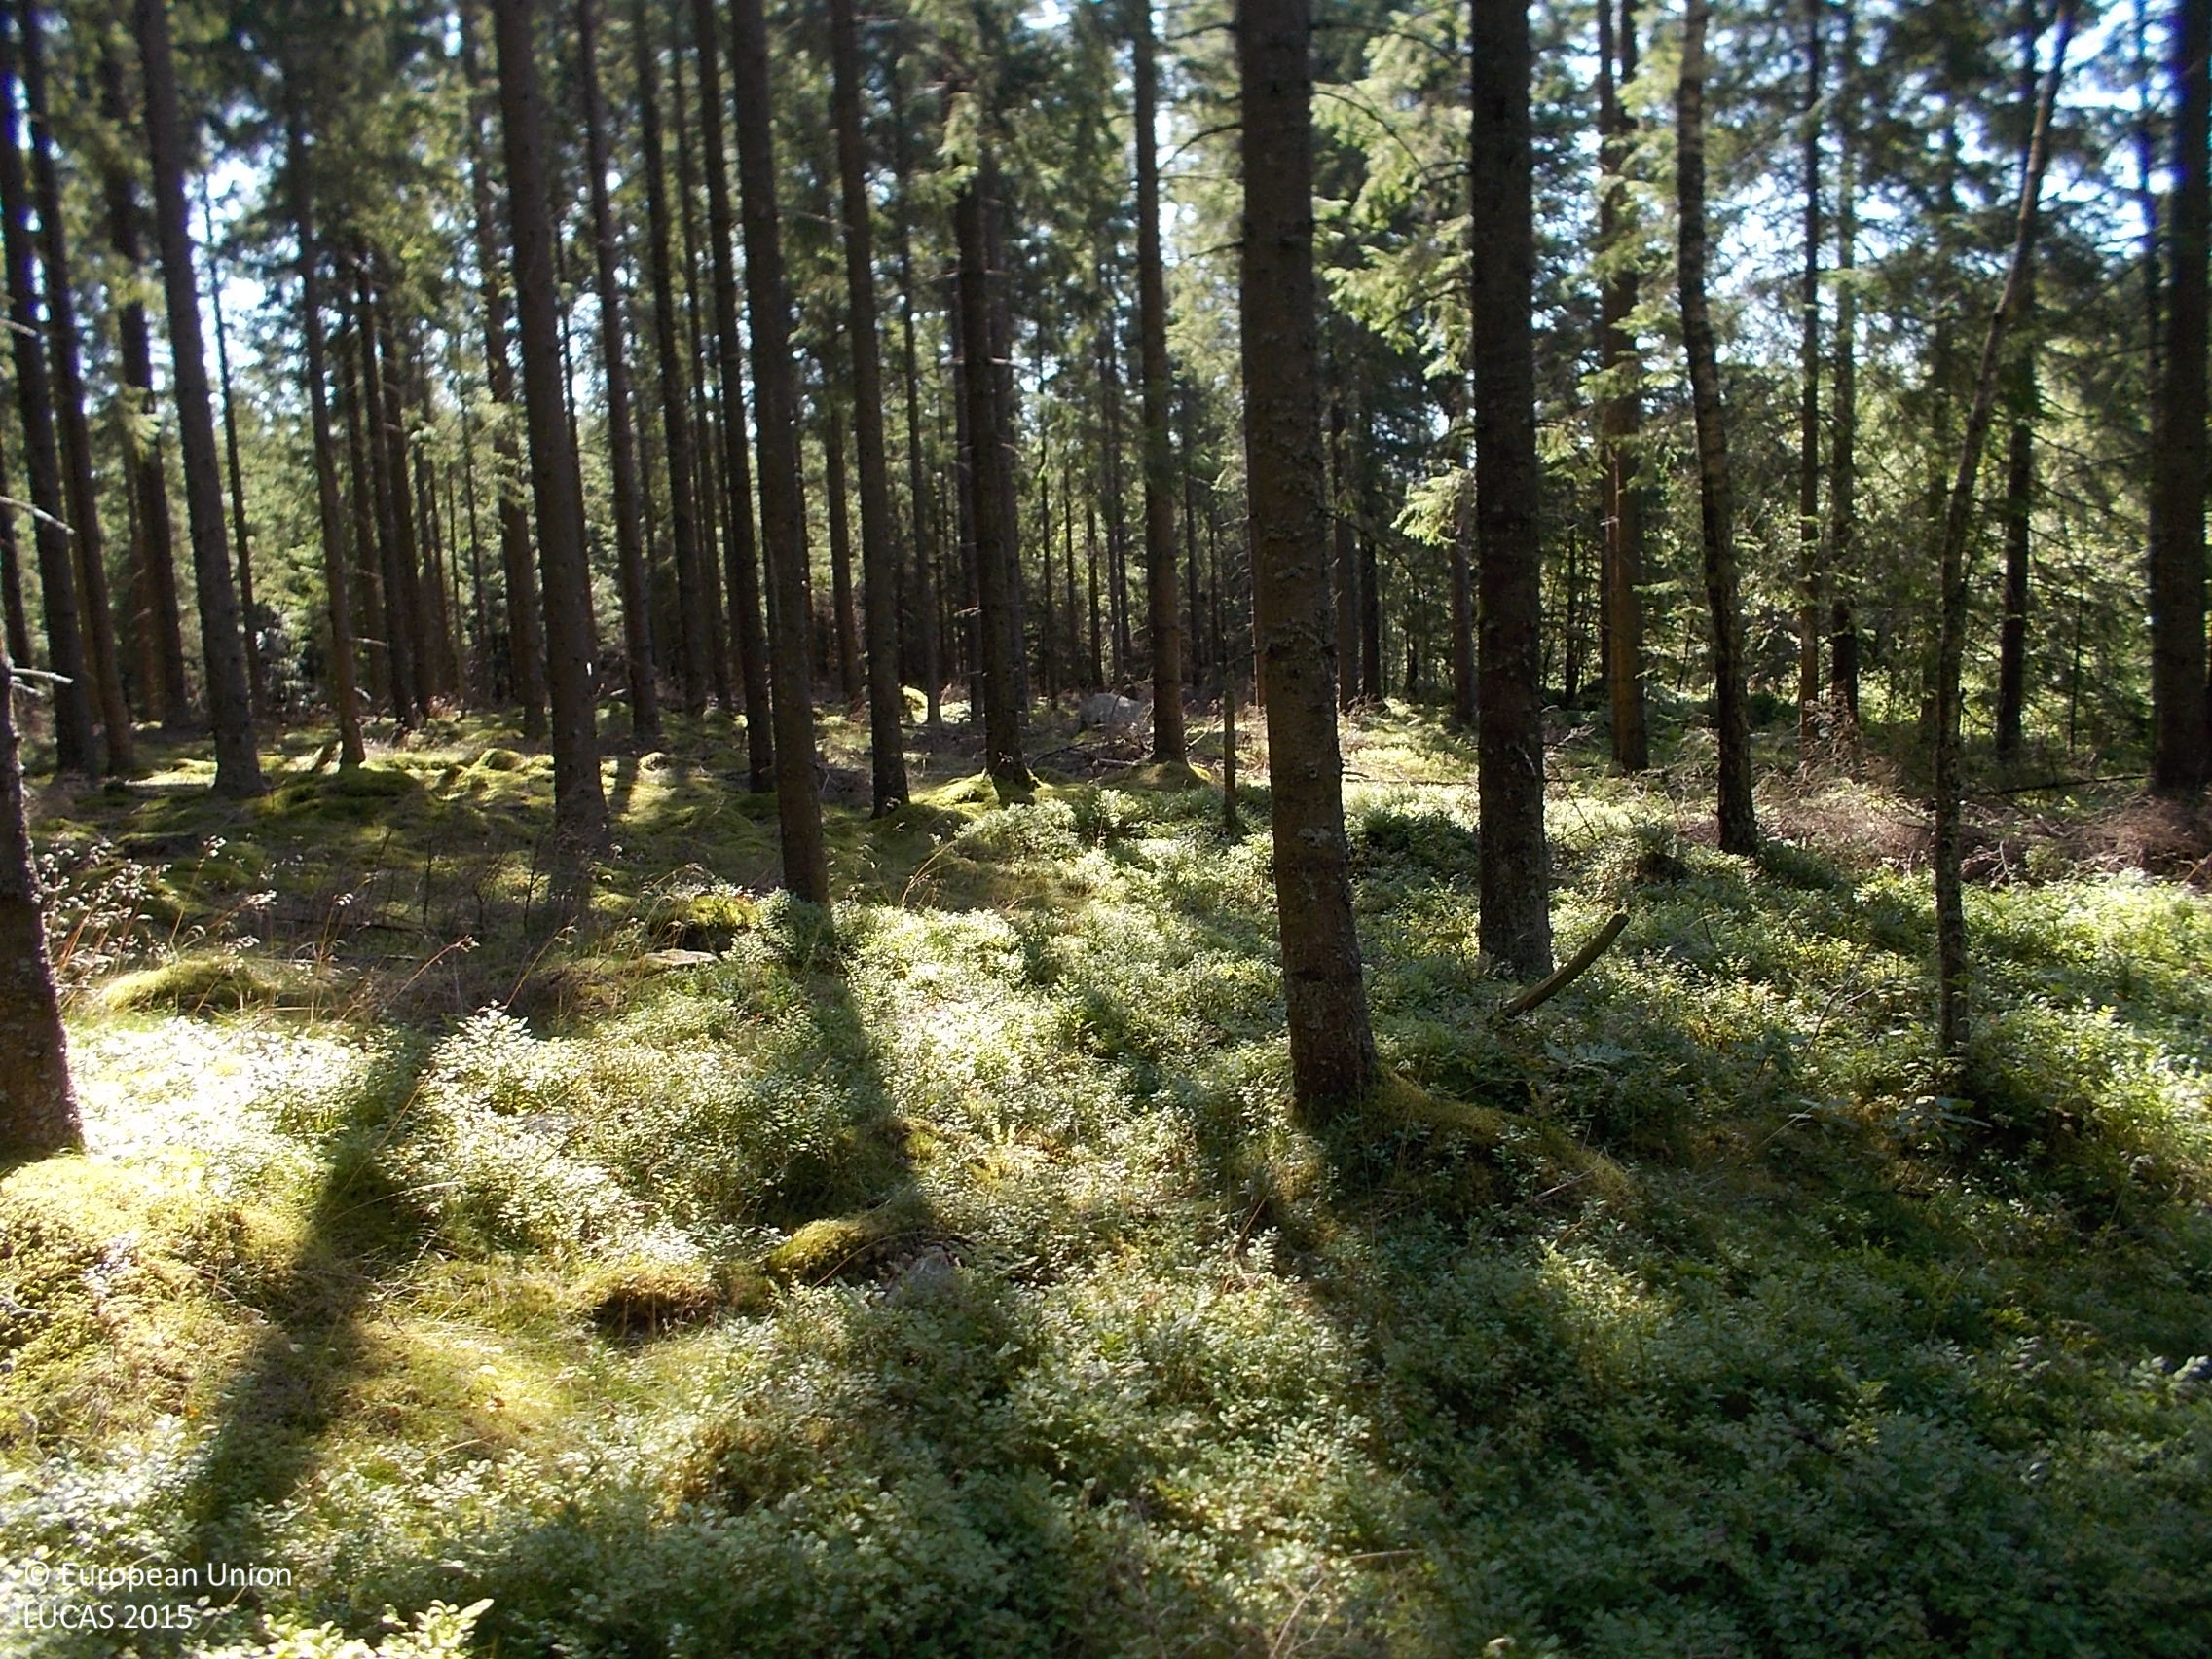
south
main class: Woodland
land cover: Spruce dominated coniferous woodland
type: boreal forest
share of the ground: > 75 %
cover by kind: coniferous forest trees 85 %, shrubs 10 %, herbaceous plants 5 %
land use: Forestry
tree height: > 5 m
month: August
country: SE
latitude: 57.4783
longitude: 13.2478
